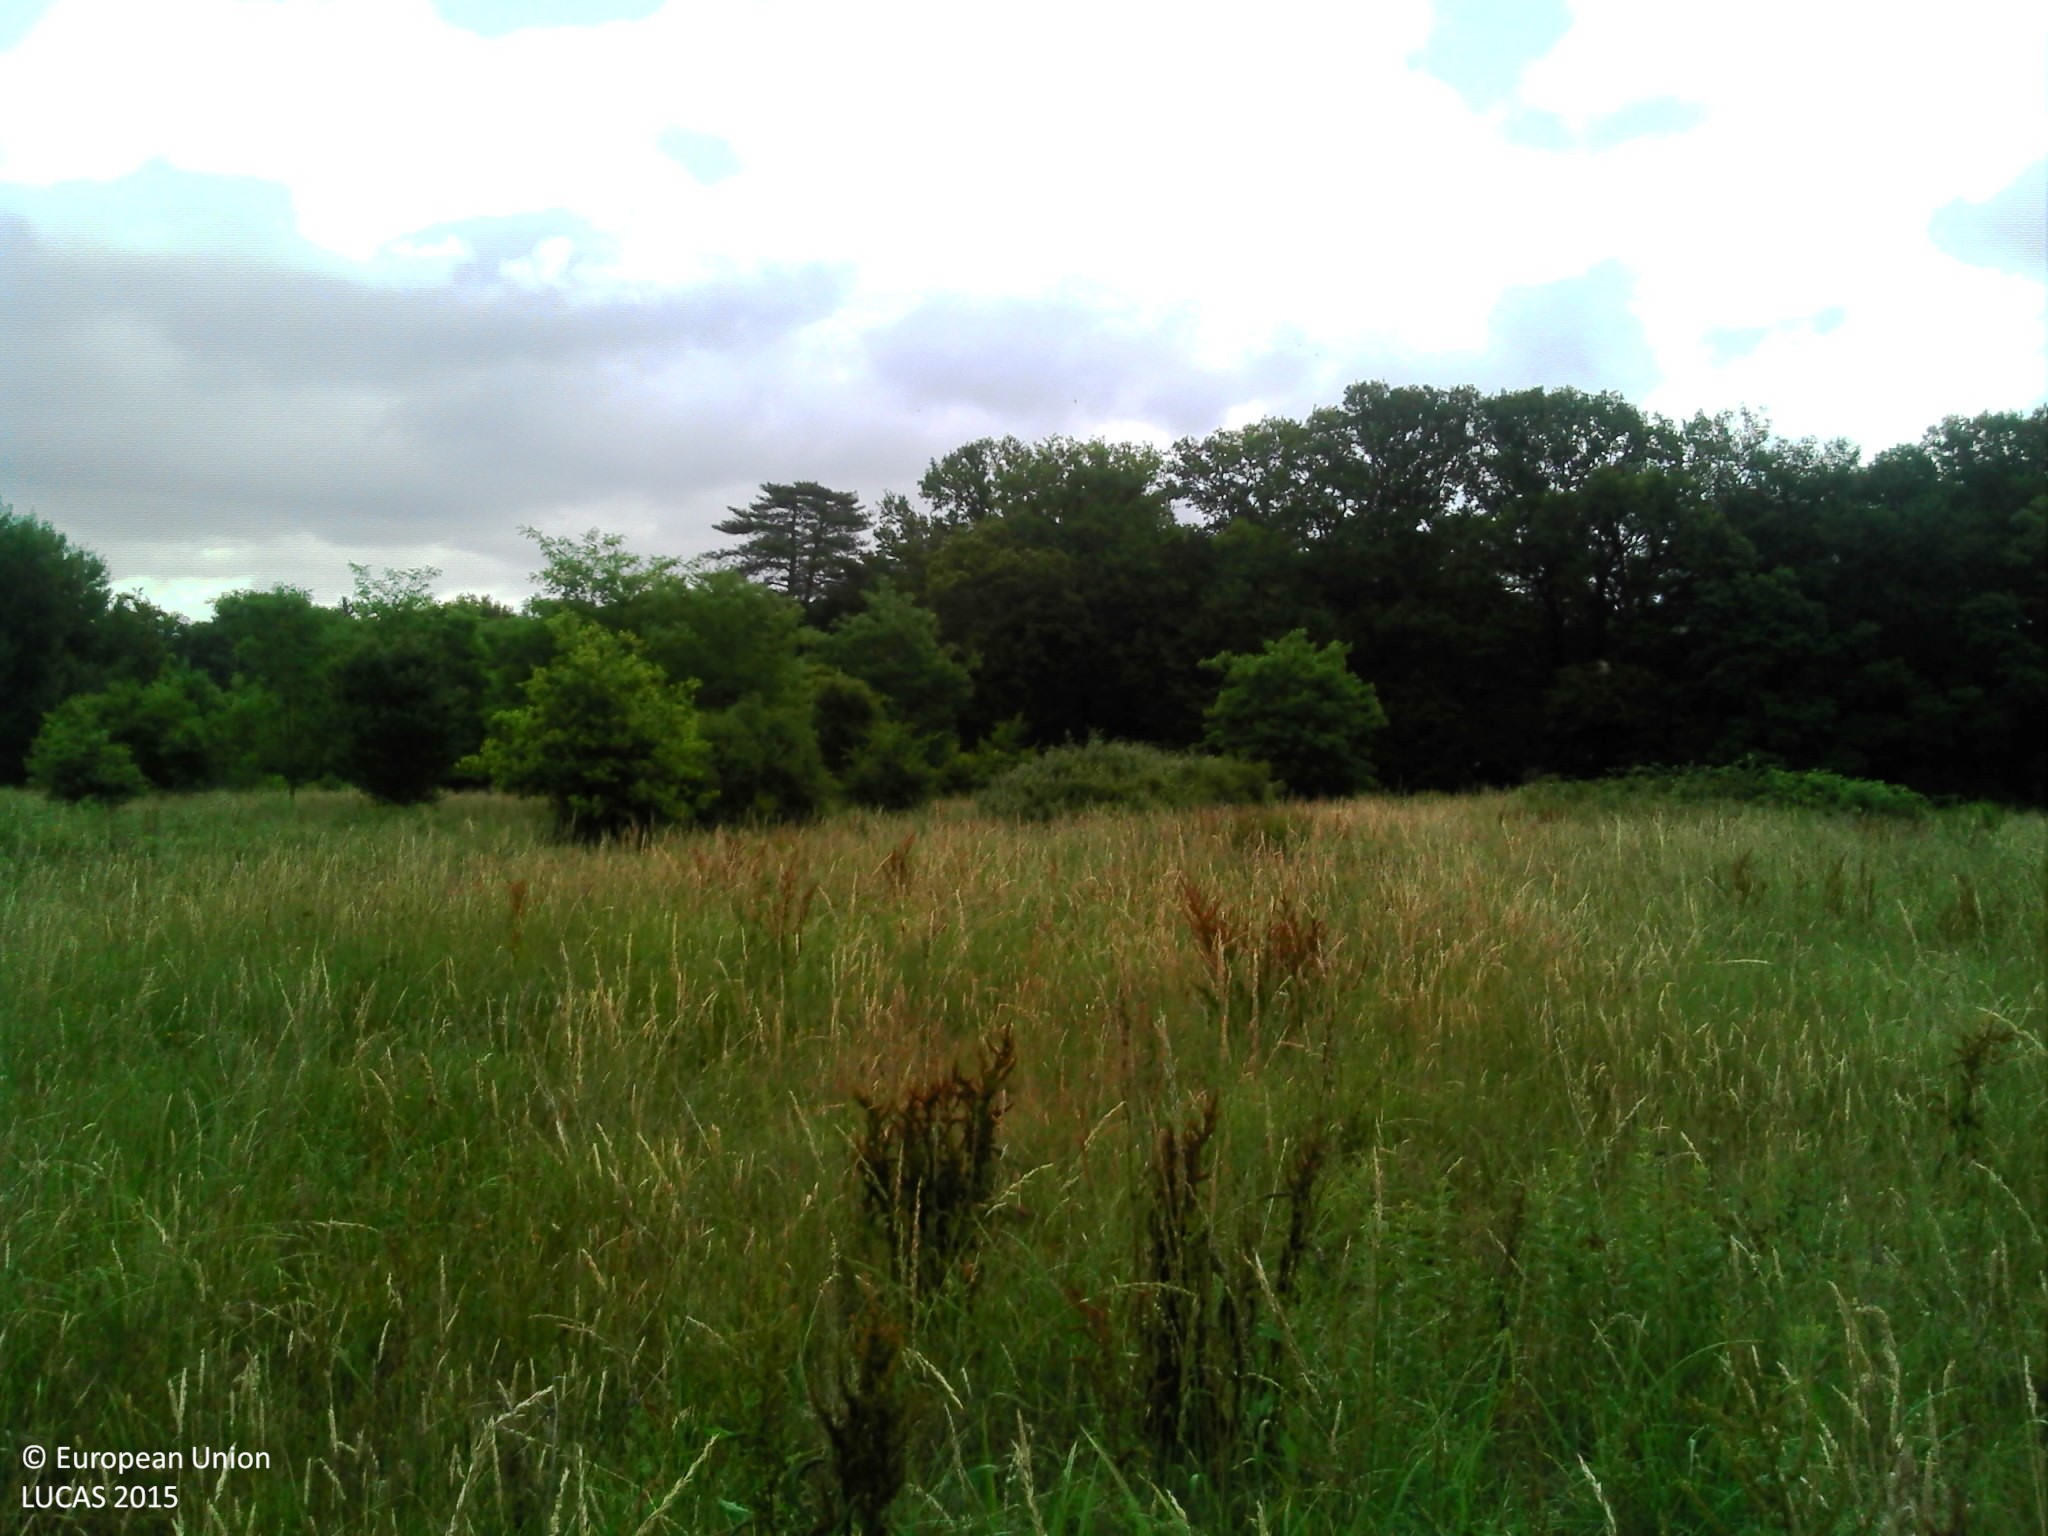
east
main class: Grassland
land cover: Grassland without tree/shrub cover
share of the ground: > 75 %
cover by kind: herbaceous plants 100 %
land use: Agriculture (excluding fallow land and kitchen gardens)
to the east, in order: Grassland without tree/shrub cover; Grassland with sparse tree/shrub cover; Broadleaved woodland; Inland fresh water bodies; Broadleaved woodland; Tracks; Broadleaved woodland
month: June
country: FR
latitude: 47.6442
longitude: 2.5238
